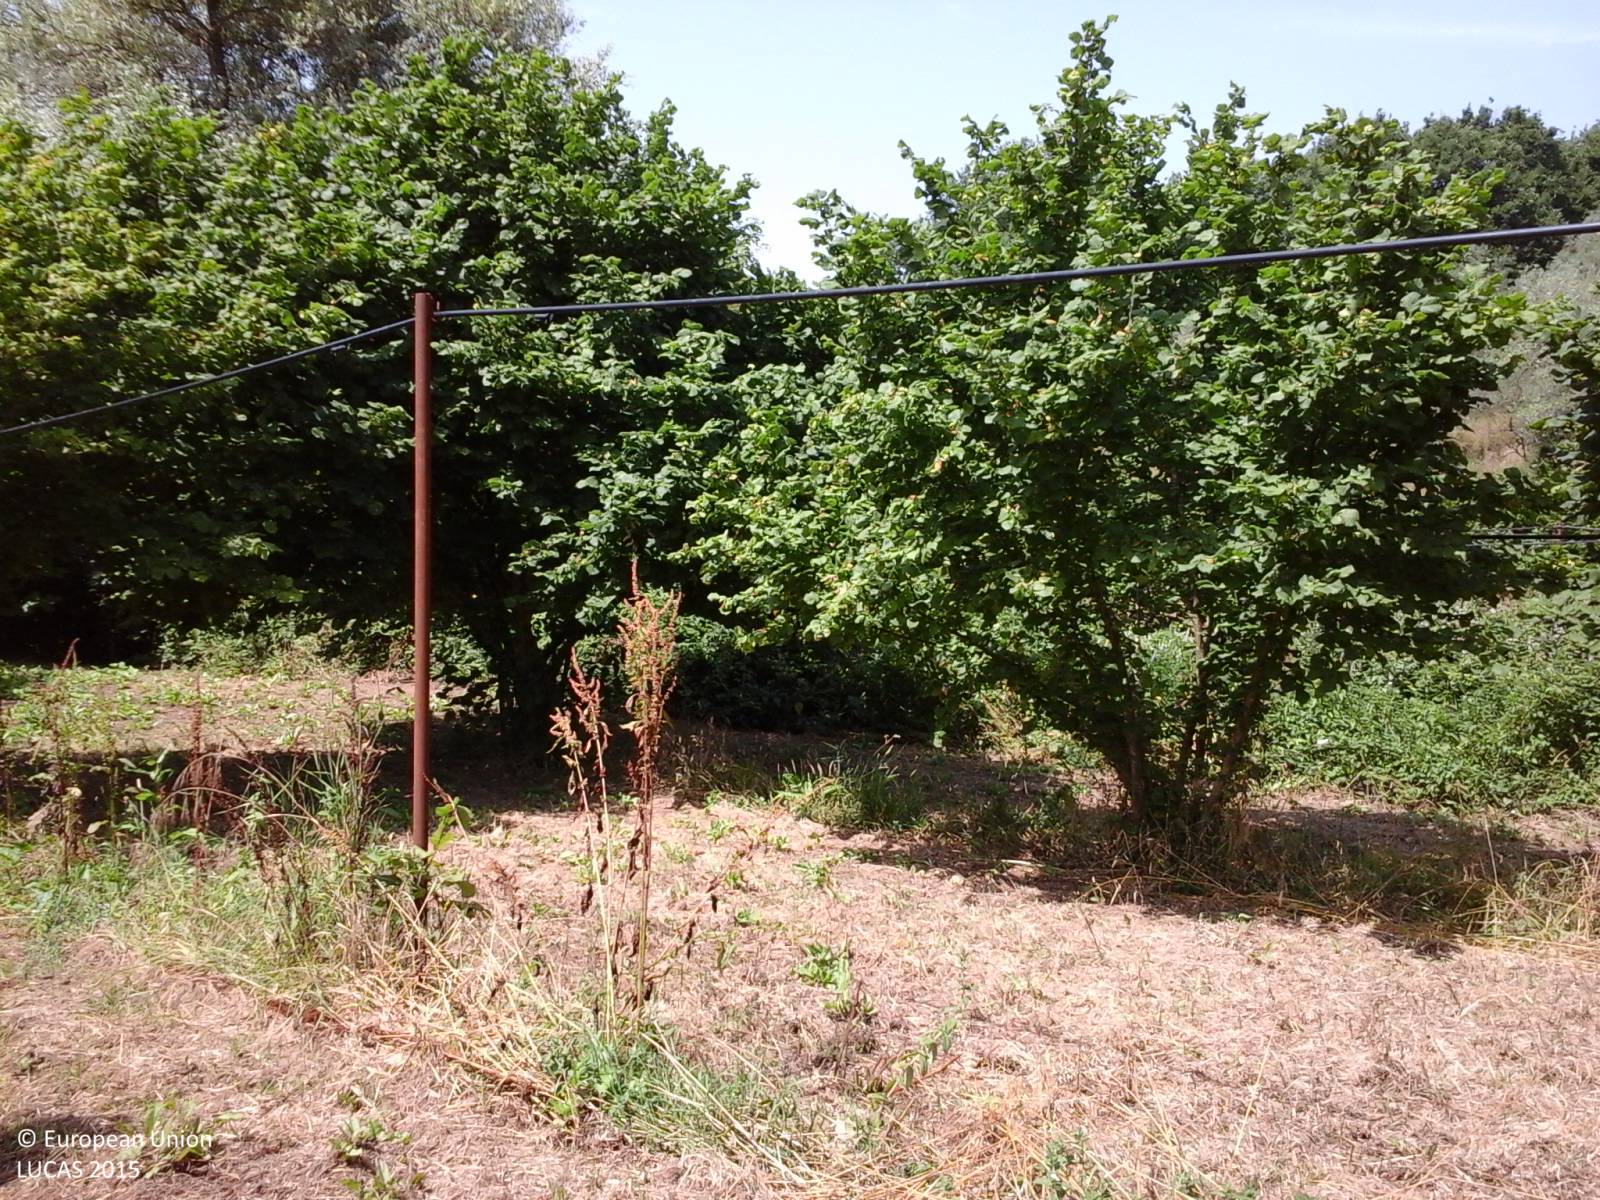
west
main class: Cropland
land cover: Nuts trees
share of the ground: > 75 %
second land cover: Grassland without tree/shrub cover
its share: > 75 %
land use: Agriculture (excluding fallow land and kitchen gardens)
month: June
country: IT
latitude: 42.4305
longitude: 12.2411
